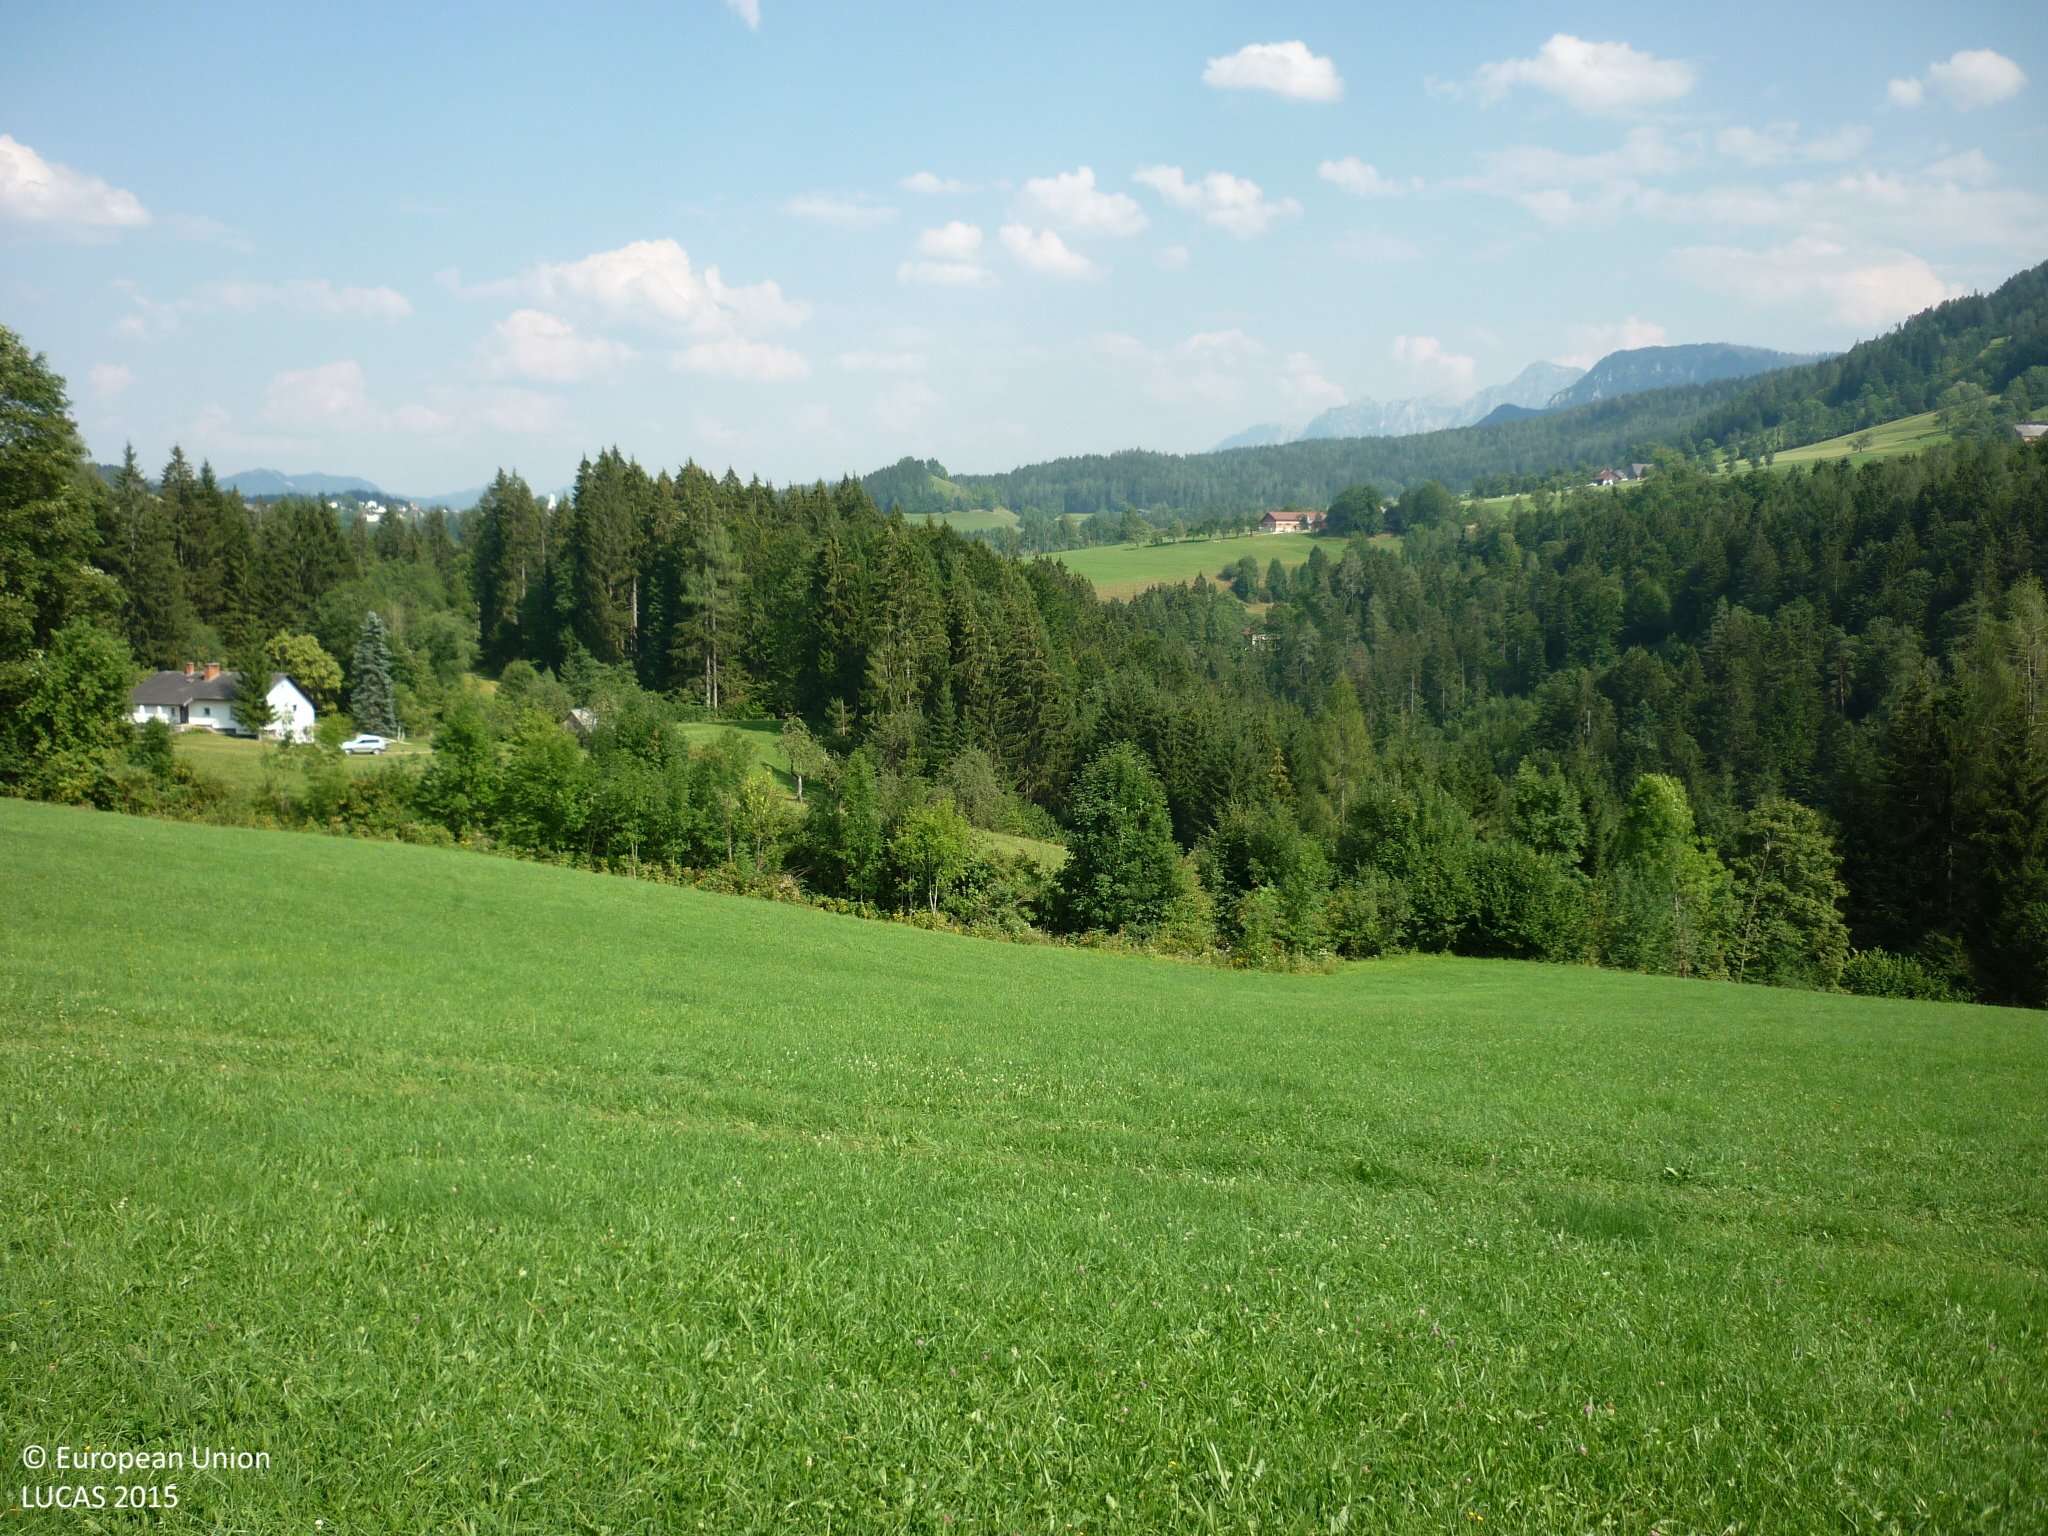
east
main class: Grassland
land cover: Grassland without tree/shrub cover
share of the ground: > 75 %
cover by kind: herbaceous plants 100 %
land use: Agriculture (excluding fallow land and kitchen gardens)
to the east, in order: Grassland without tree/shrub cover; Tracks; Grassland without tree/shrub cover; Fences; Abandoned hedges; Grassland without tree/shrub cover; Grassland with sparse tree/shrub cover; Fences; Grassland without tree/shrub cover; Tracks; Other fruit trees and berries; Grassland without tree/shrub cover
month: August
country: AT
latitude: 47.7112
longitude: 14.1977
